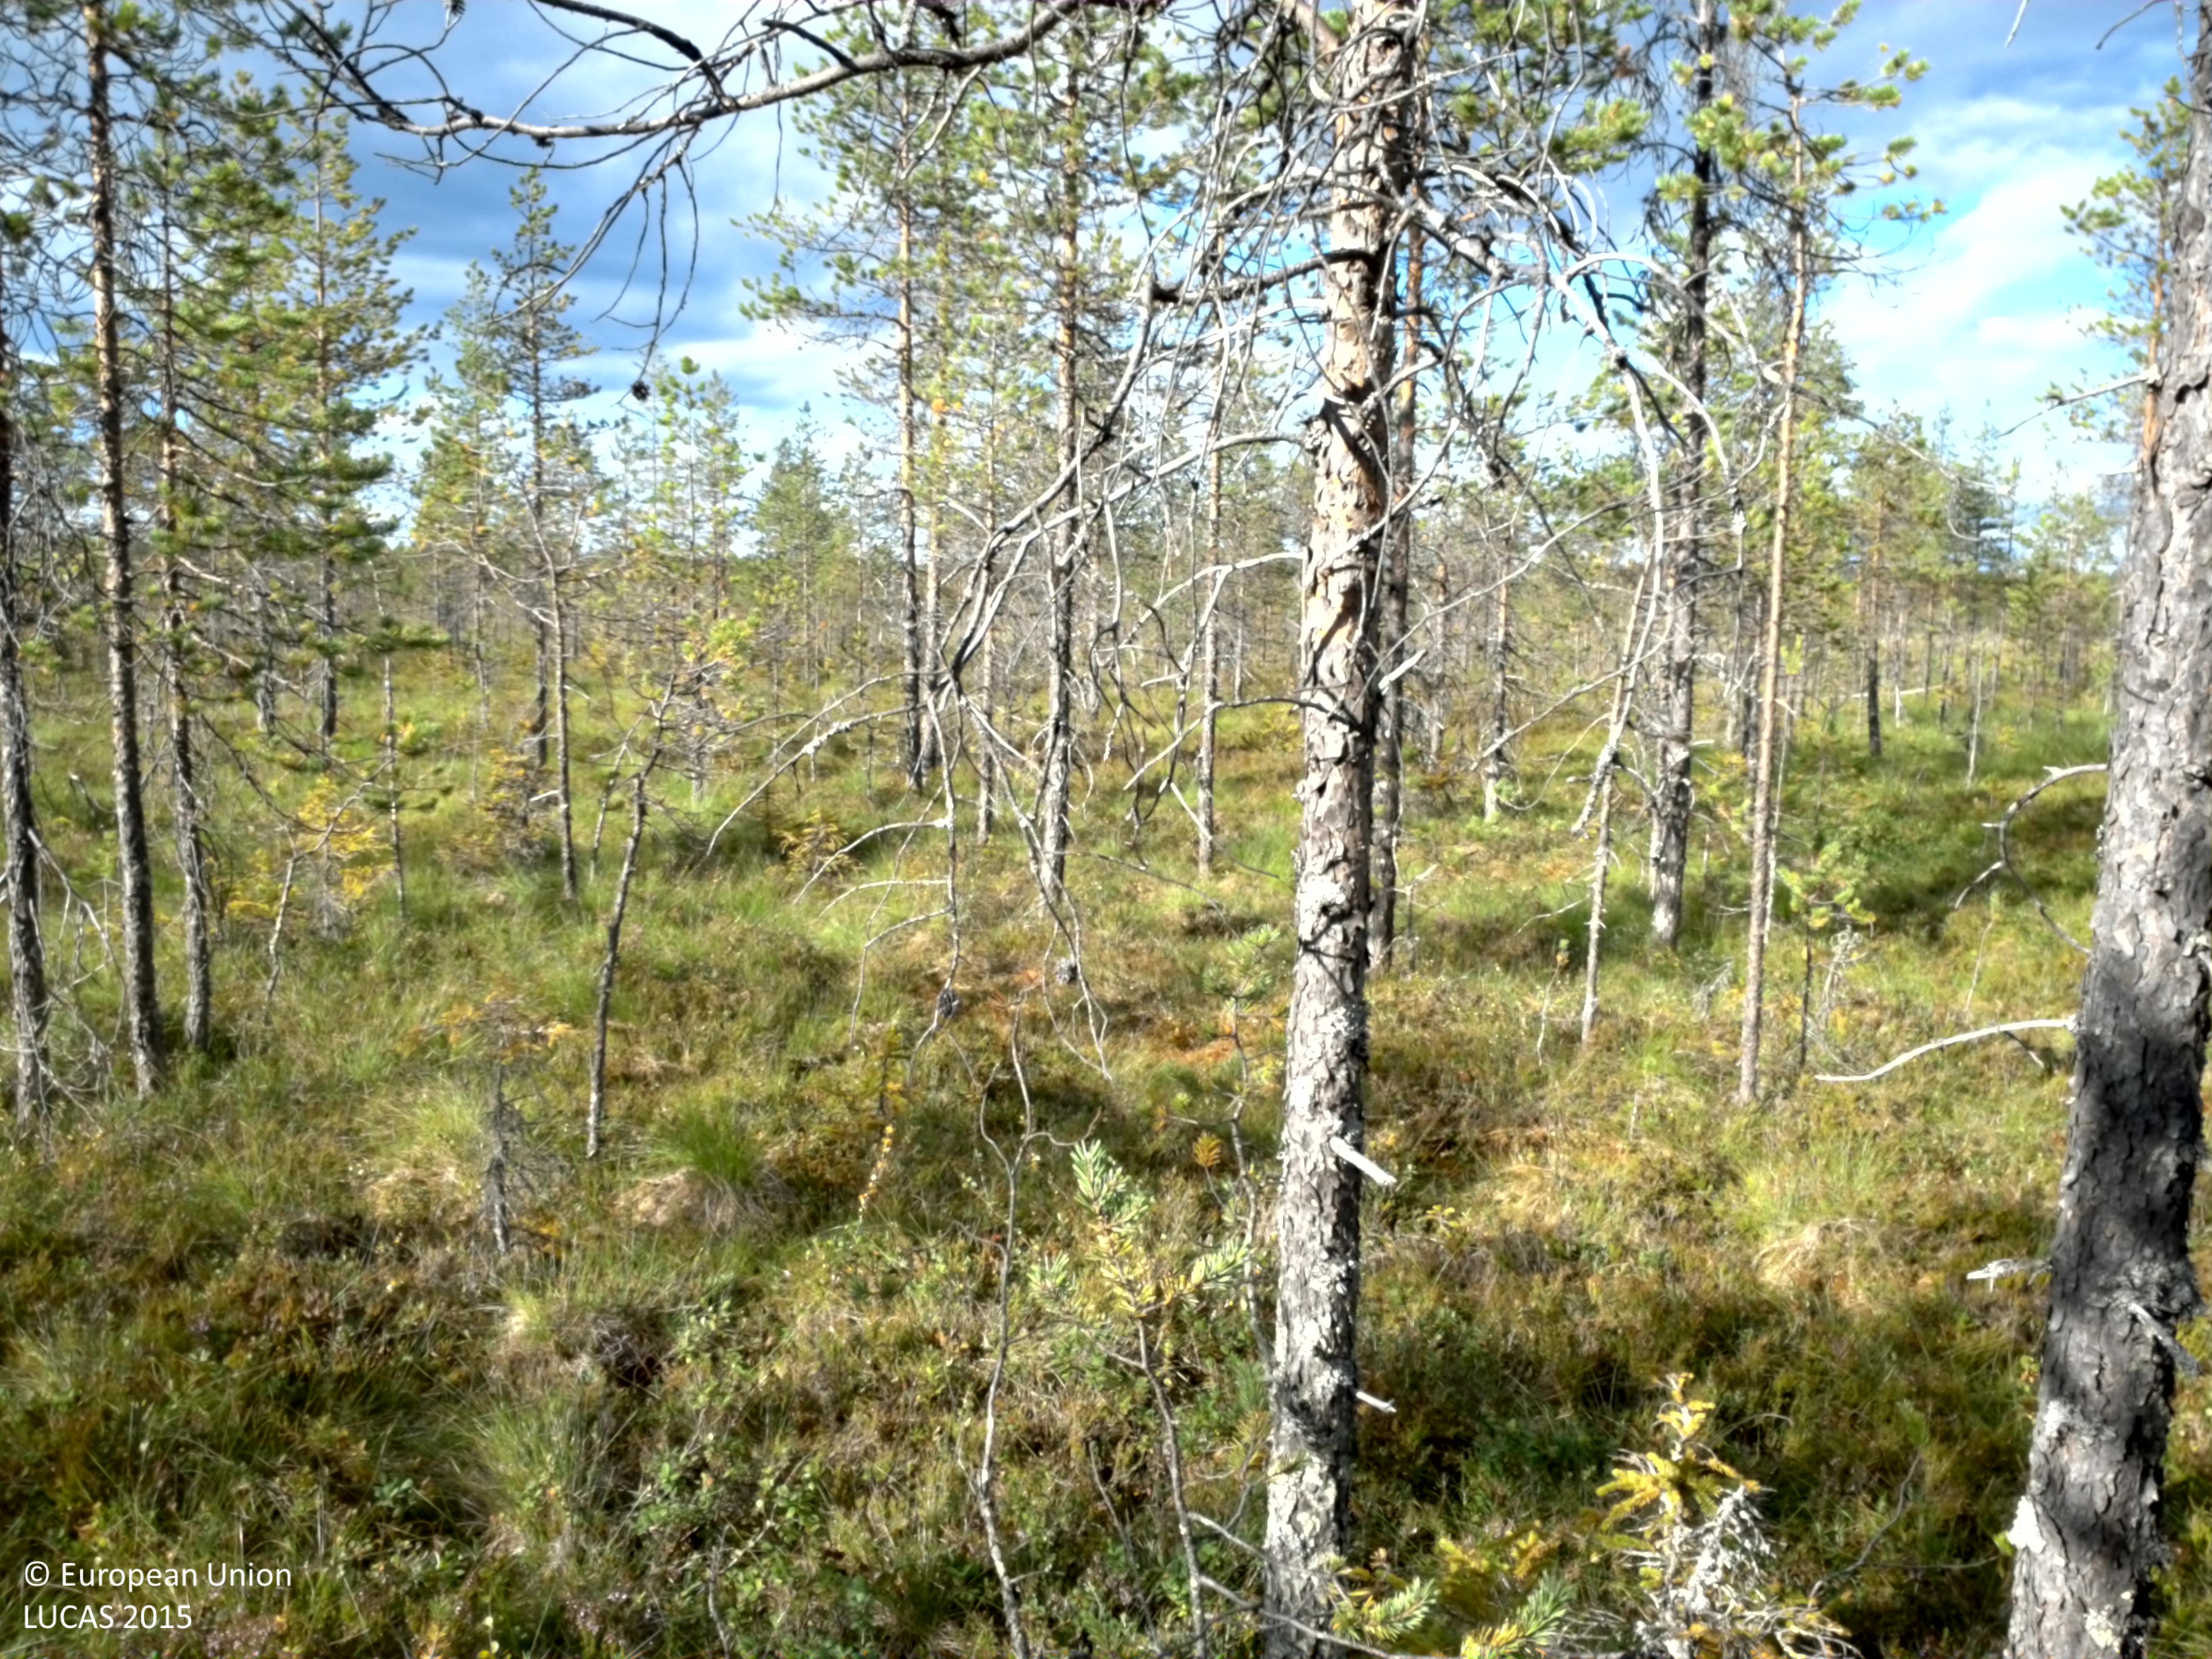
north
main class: Woodland
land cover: Pine dominated coniferous woodland
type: boreal forest
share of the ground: 10 - 25 %
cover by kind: shrubs 70 %, coniferous forest trees 15 %, herbaceous plants 10 %, lichens and mosses 5 %
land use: Semi-natural and natural areas not in use
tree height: > 5 m
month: August
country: SE
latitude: 66.1635
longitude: 22.6846
